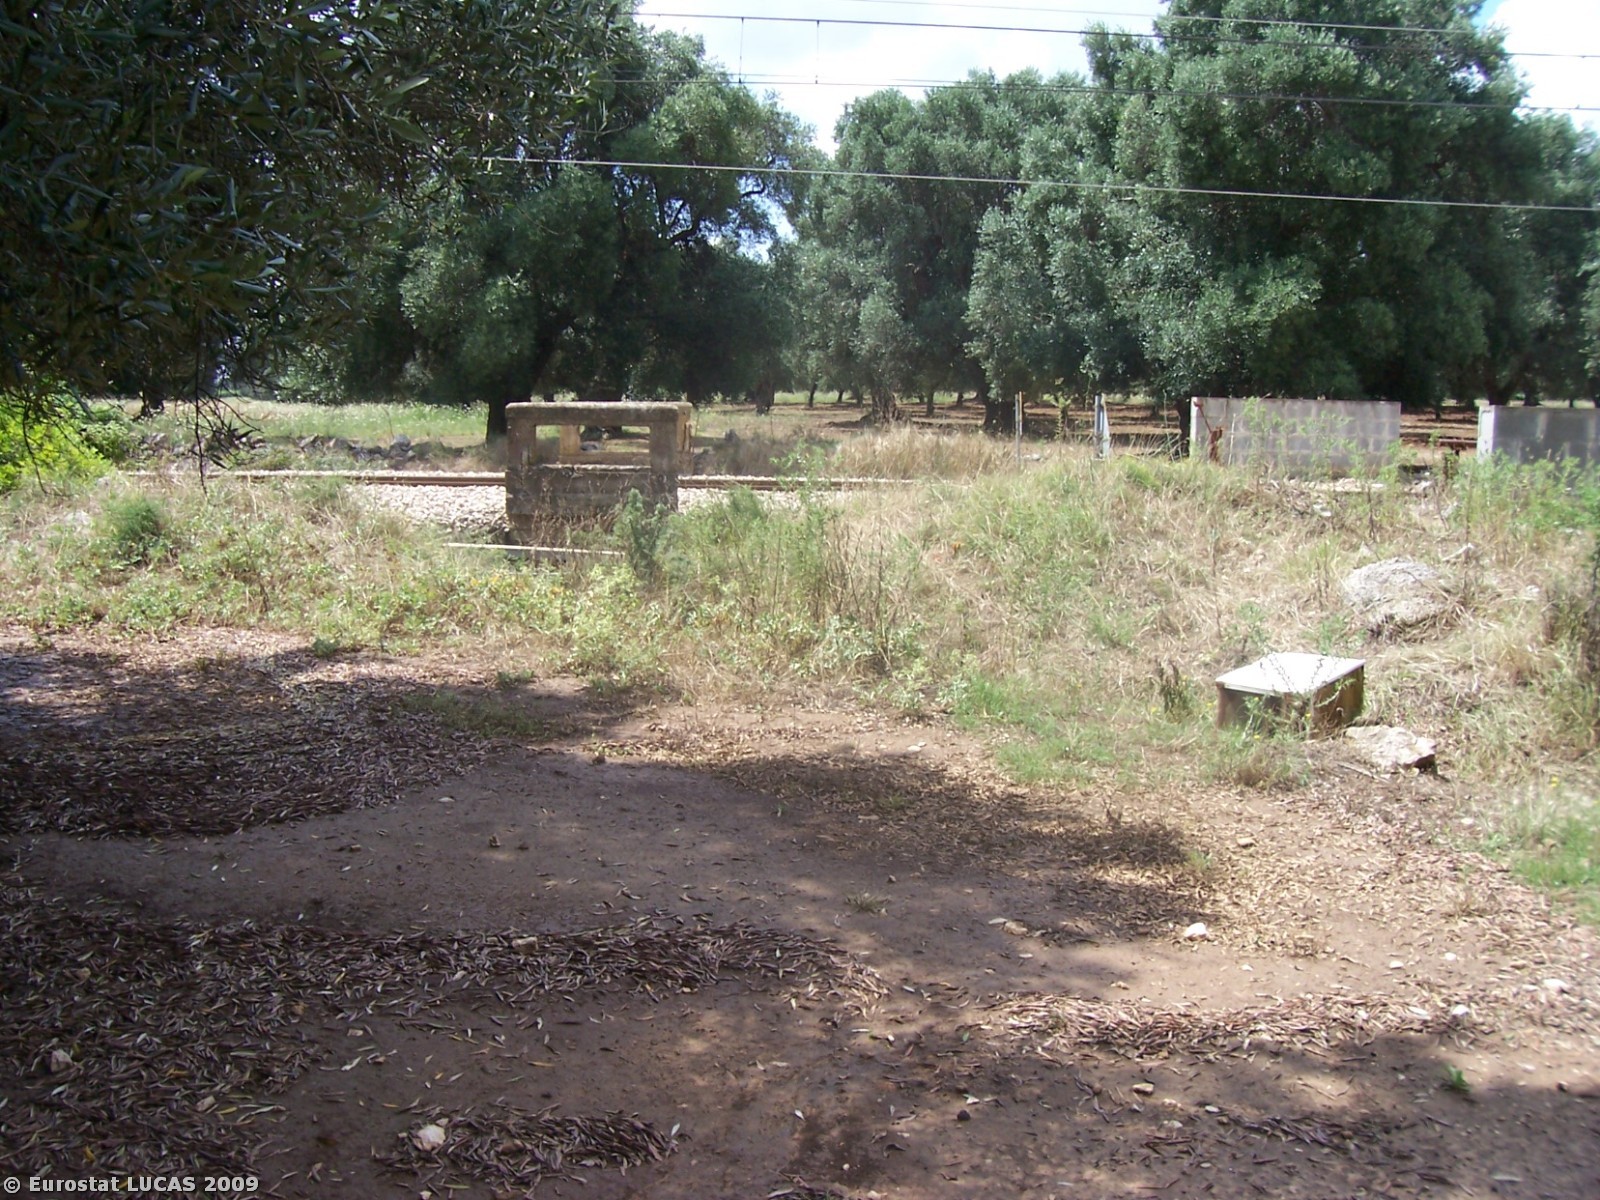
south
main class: Cropland
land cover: Olive groves
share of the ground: 50 - 75 %
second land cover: Bare land
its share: > 75 %
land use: Agriculture (excluding fallow land and kitchen gardens)
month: July
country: IT
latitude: 40.5234
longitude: 17.5186
